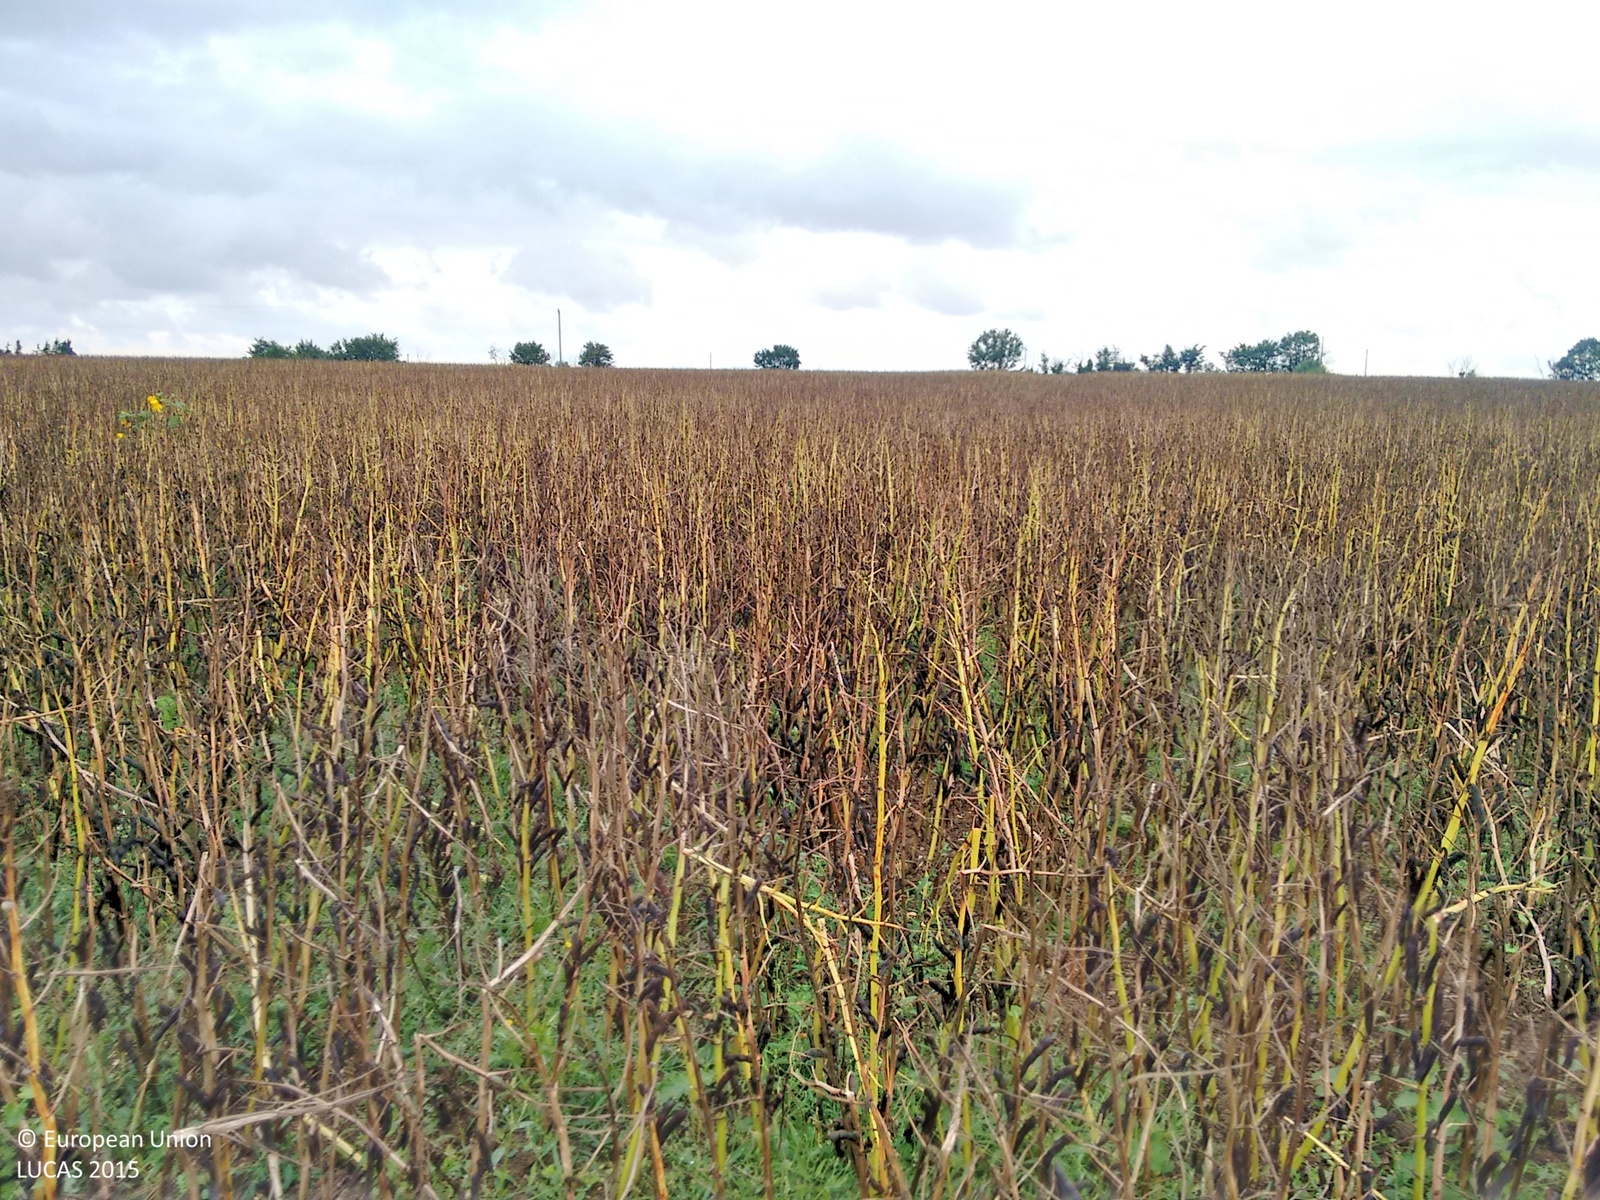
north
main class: Cropland
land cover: Dry pulses
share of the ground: > 75 %
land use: Agriculture (excluding fallow land and kitchen gardens)
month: August
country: GB
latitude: 52.0863
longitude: 0.5008
